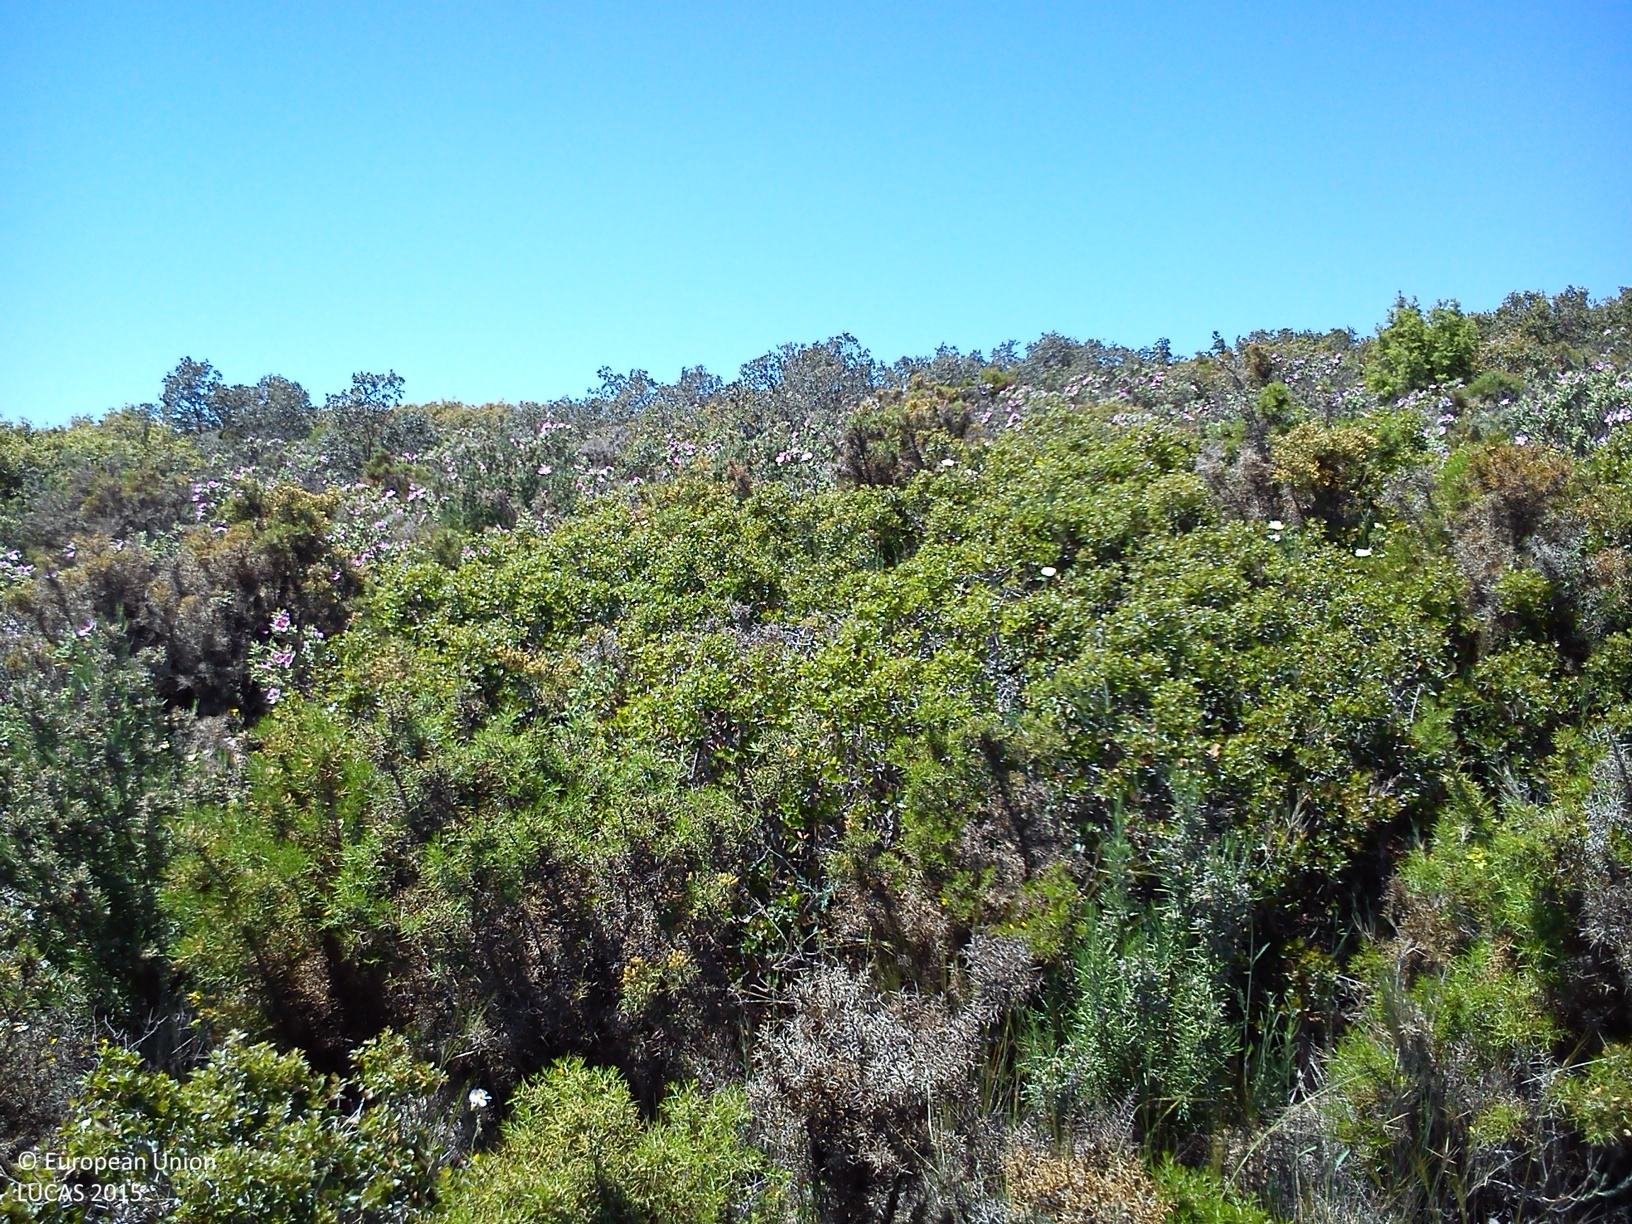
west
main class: Shrubland
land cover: Shrubland without tree cover
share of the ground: > 75 %
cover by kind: shrubs 85 %, consolidated bare surface 10 %, herbaceous plants 5 %
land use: Semi-natural and natural areas not in use
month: May
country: ES
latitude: 39.5380
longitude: -0.8327
